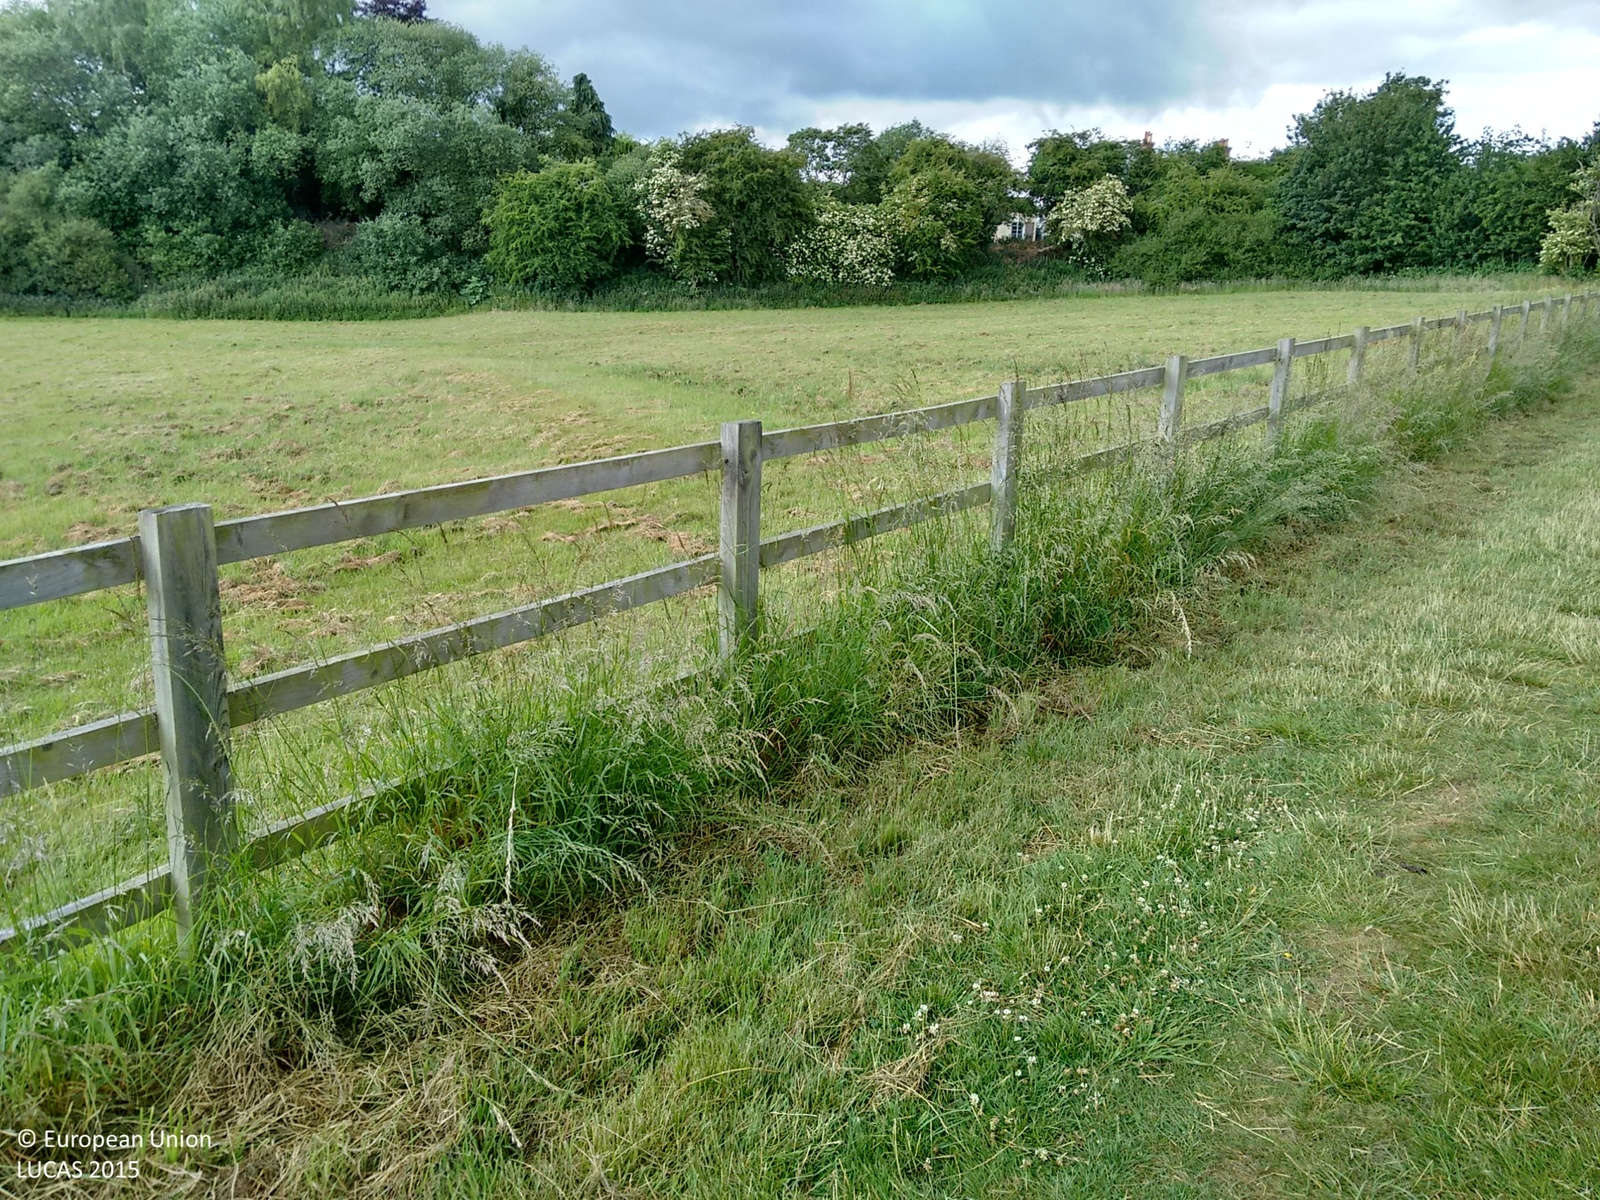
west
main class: Grassland
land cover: Grassland without tree/shrub cover
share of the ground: > 75 %
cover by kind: herbaceous plants 100 %
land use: Agriculture (excluding fallow land and kitchen gardens)
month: June
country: GB
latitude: 51.5145
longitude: -1.2443
